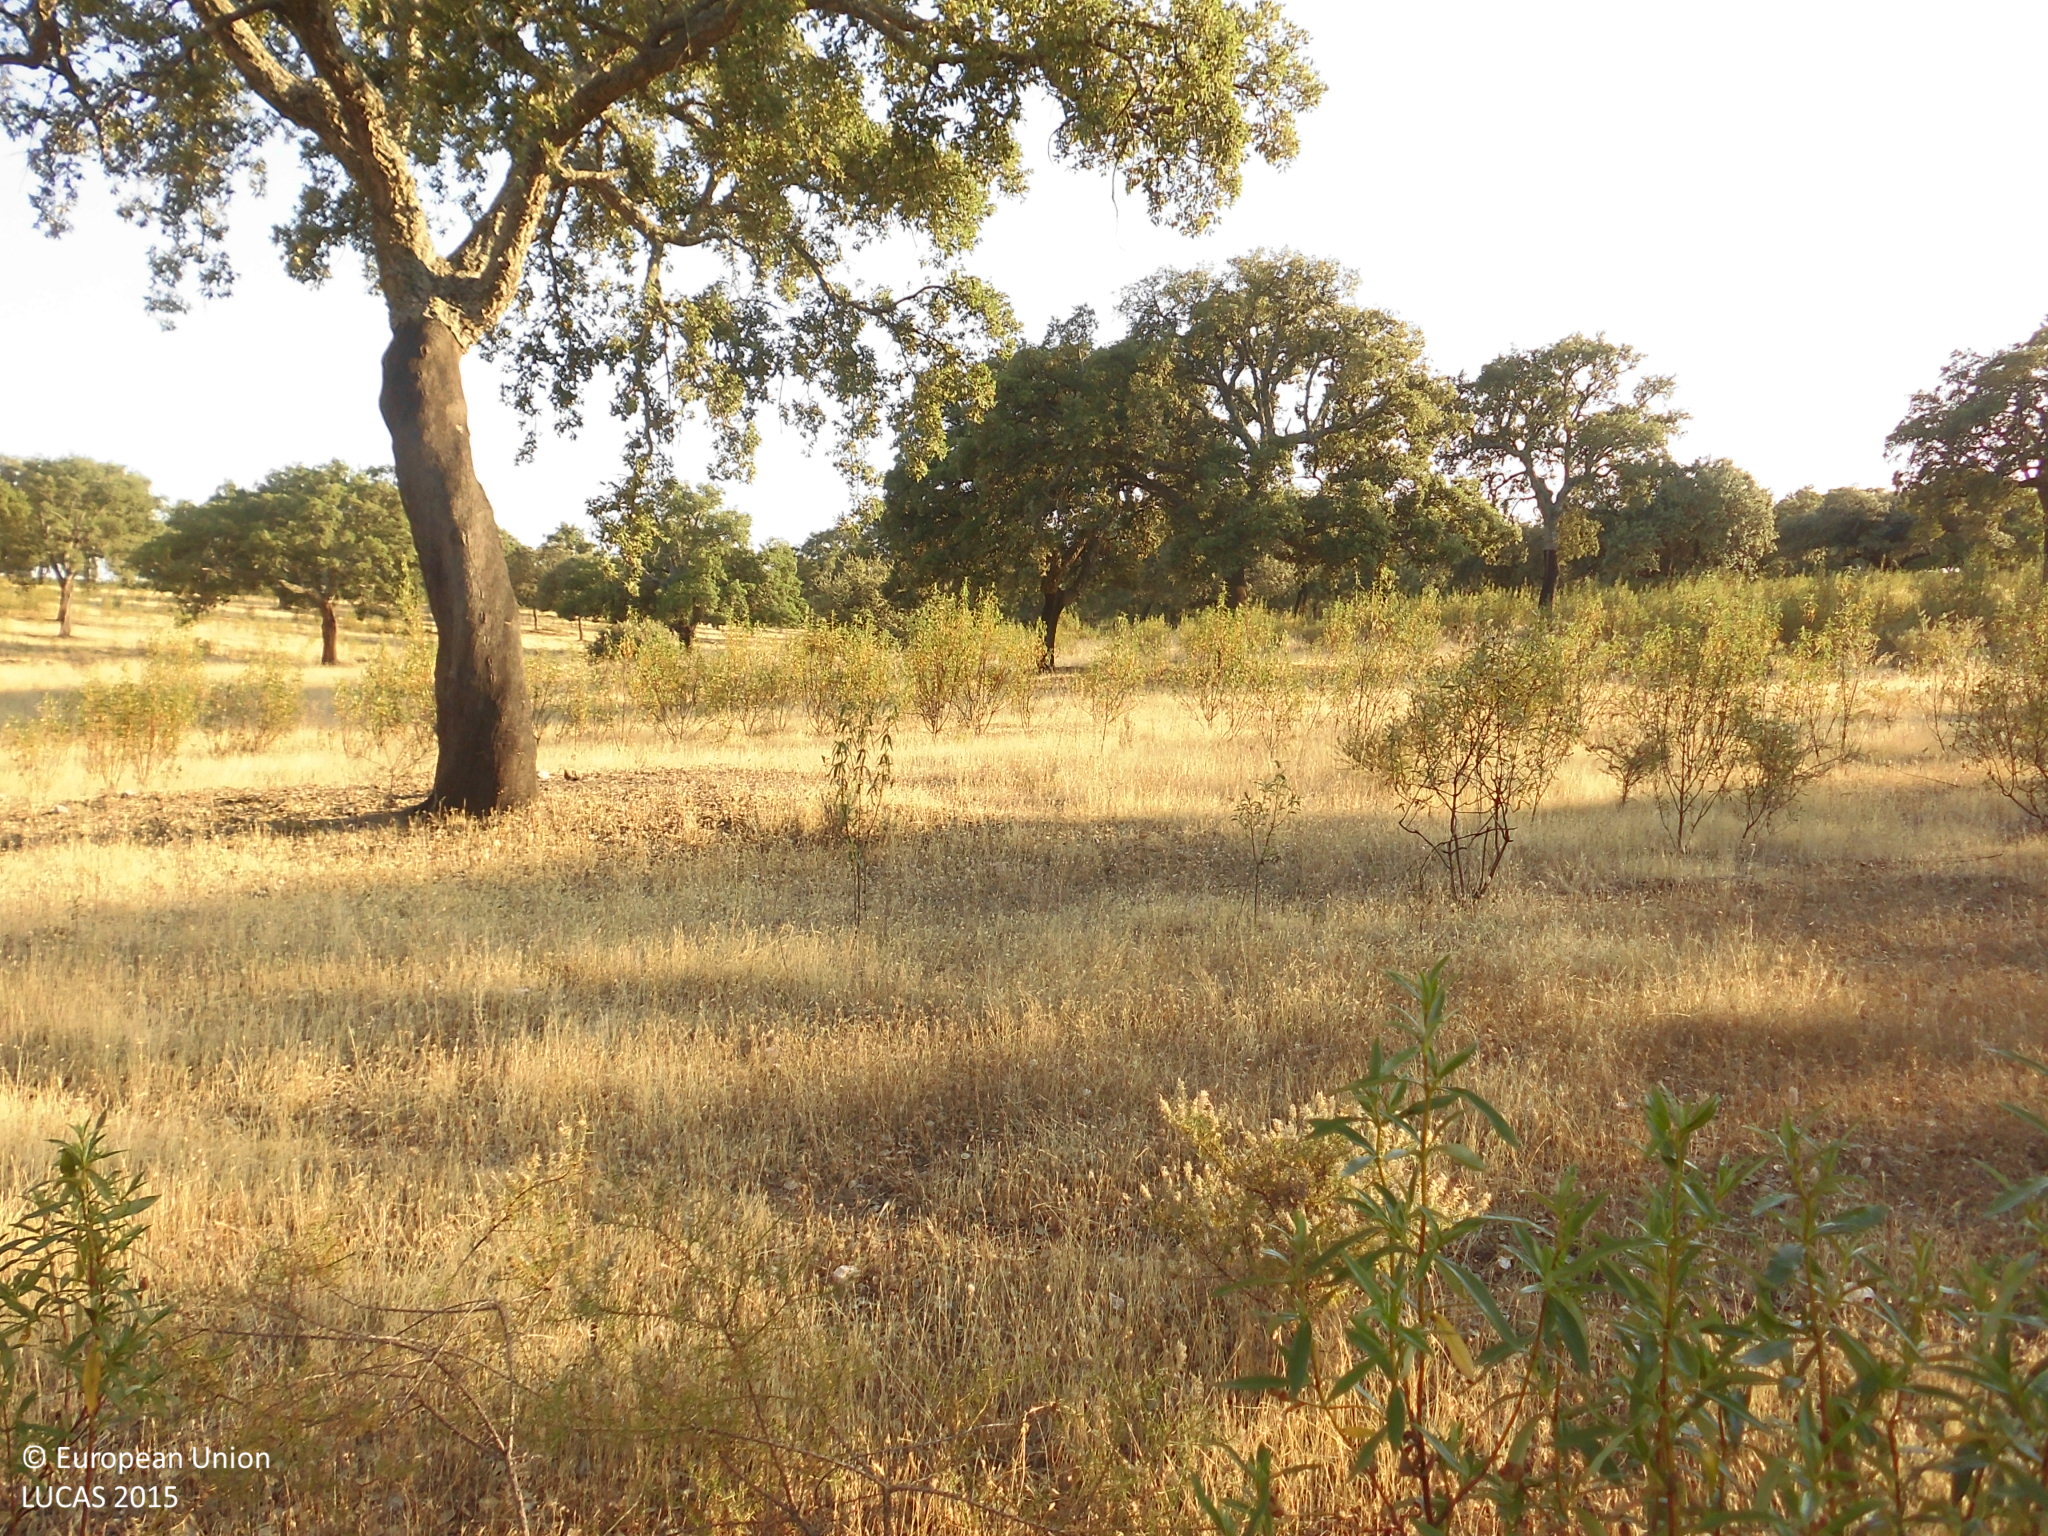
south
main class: Woodland
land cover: Broadleaved woodland
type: broadleaved evergreen forest
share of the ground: 10 - 25 %
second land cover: Grassland without tree/shrub cover
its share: > 75 %
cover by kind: herbaceous plants 60 %, broadleaved forest trees 30 %, shrubs 10 %
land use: Forestry
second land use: Agriculture (excluding fallow land and kitchen gardens)
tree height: > 5 m
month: June
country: ES
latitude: 39.9213
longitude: -5.9913
